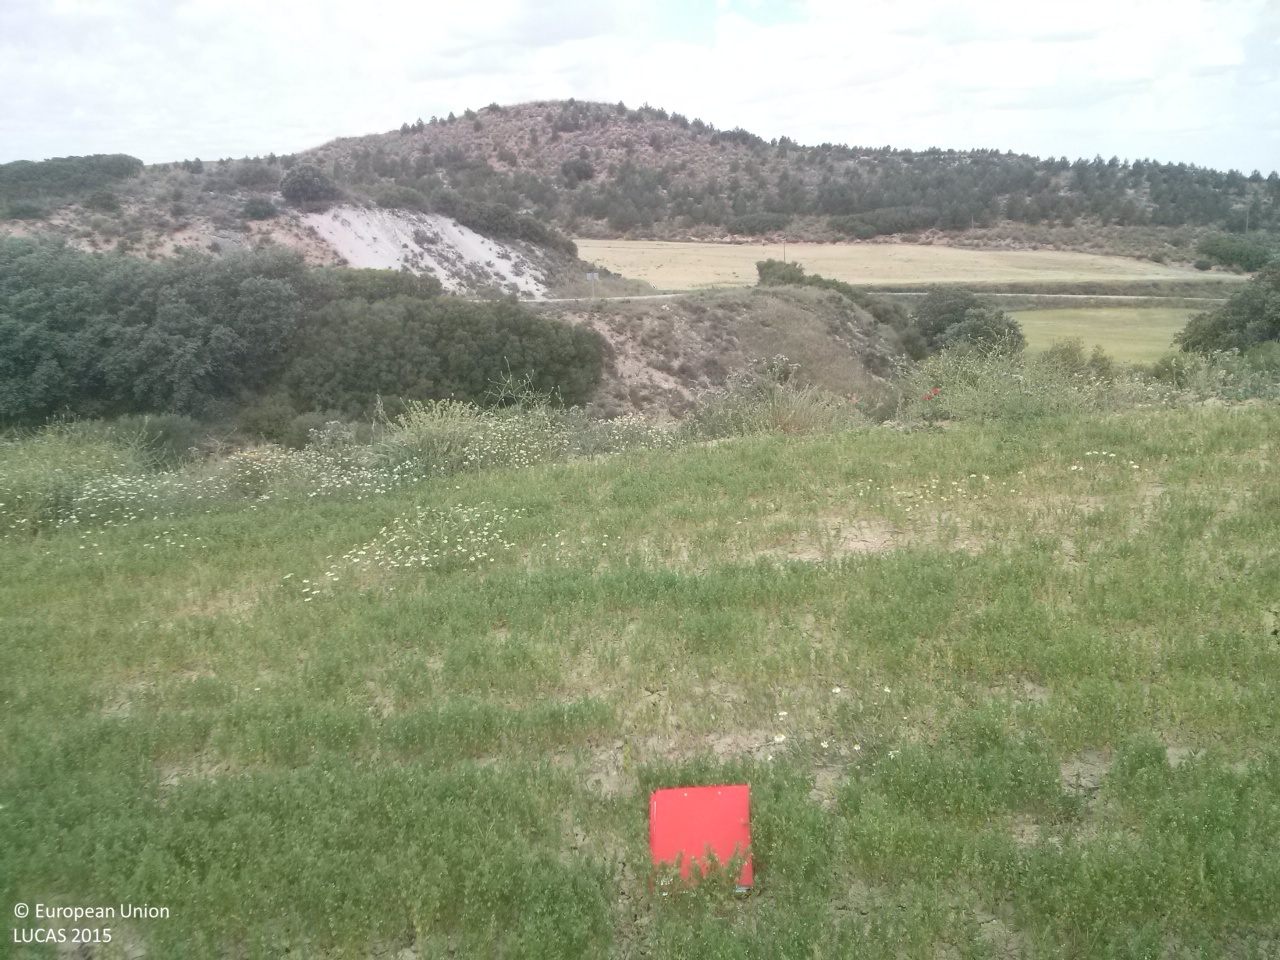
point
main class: Cropland
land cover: Dry pulses
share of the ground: > 75 %
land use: Agriculture (excluding fallow land and kitchen gardens)
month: May
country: ES
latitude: 40.1079
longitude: -2.8935
